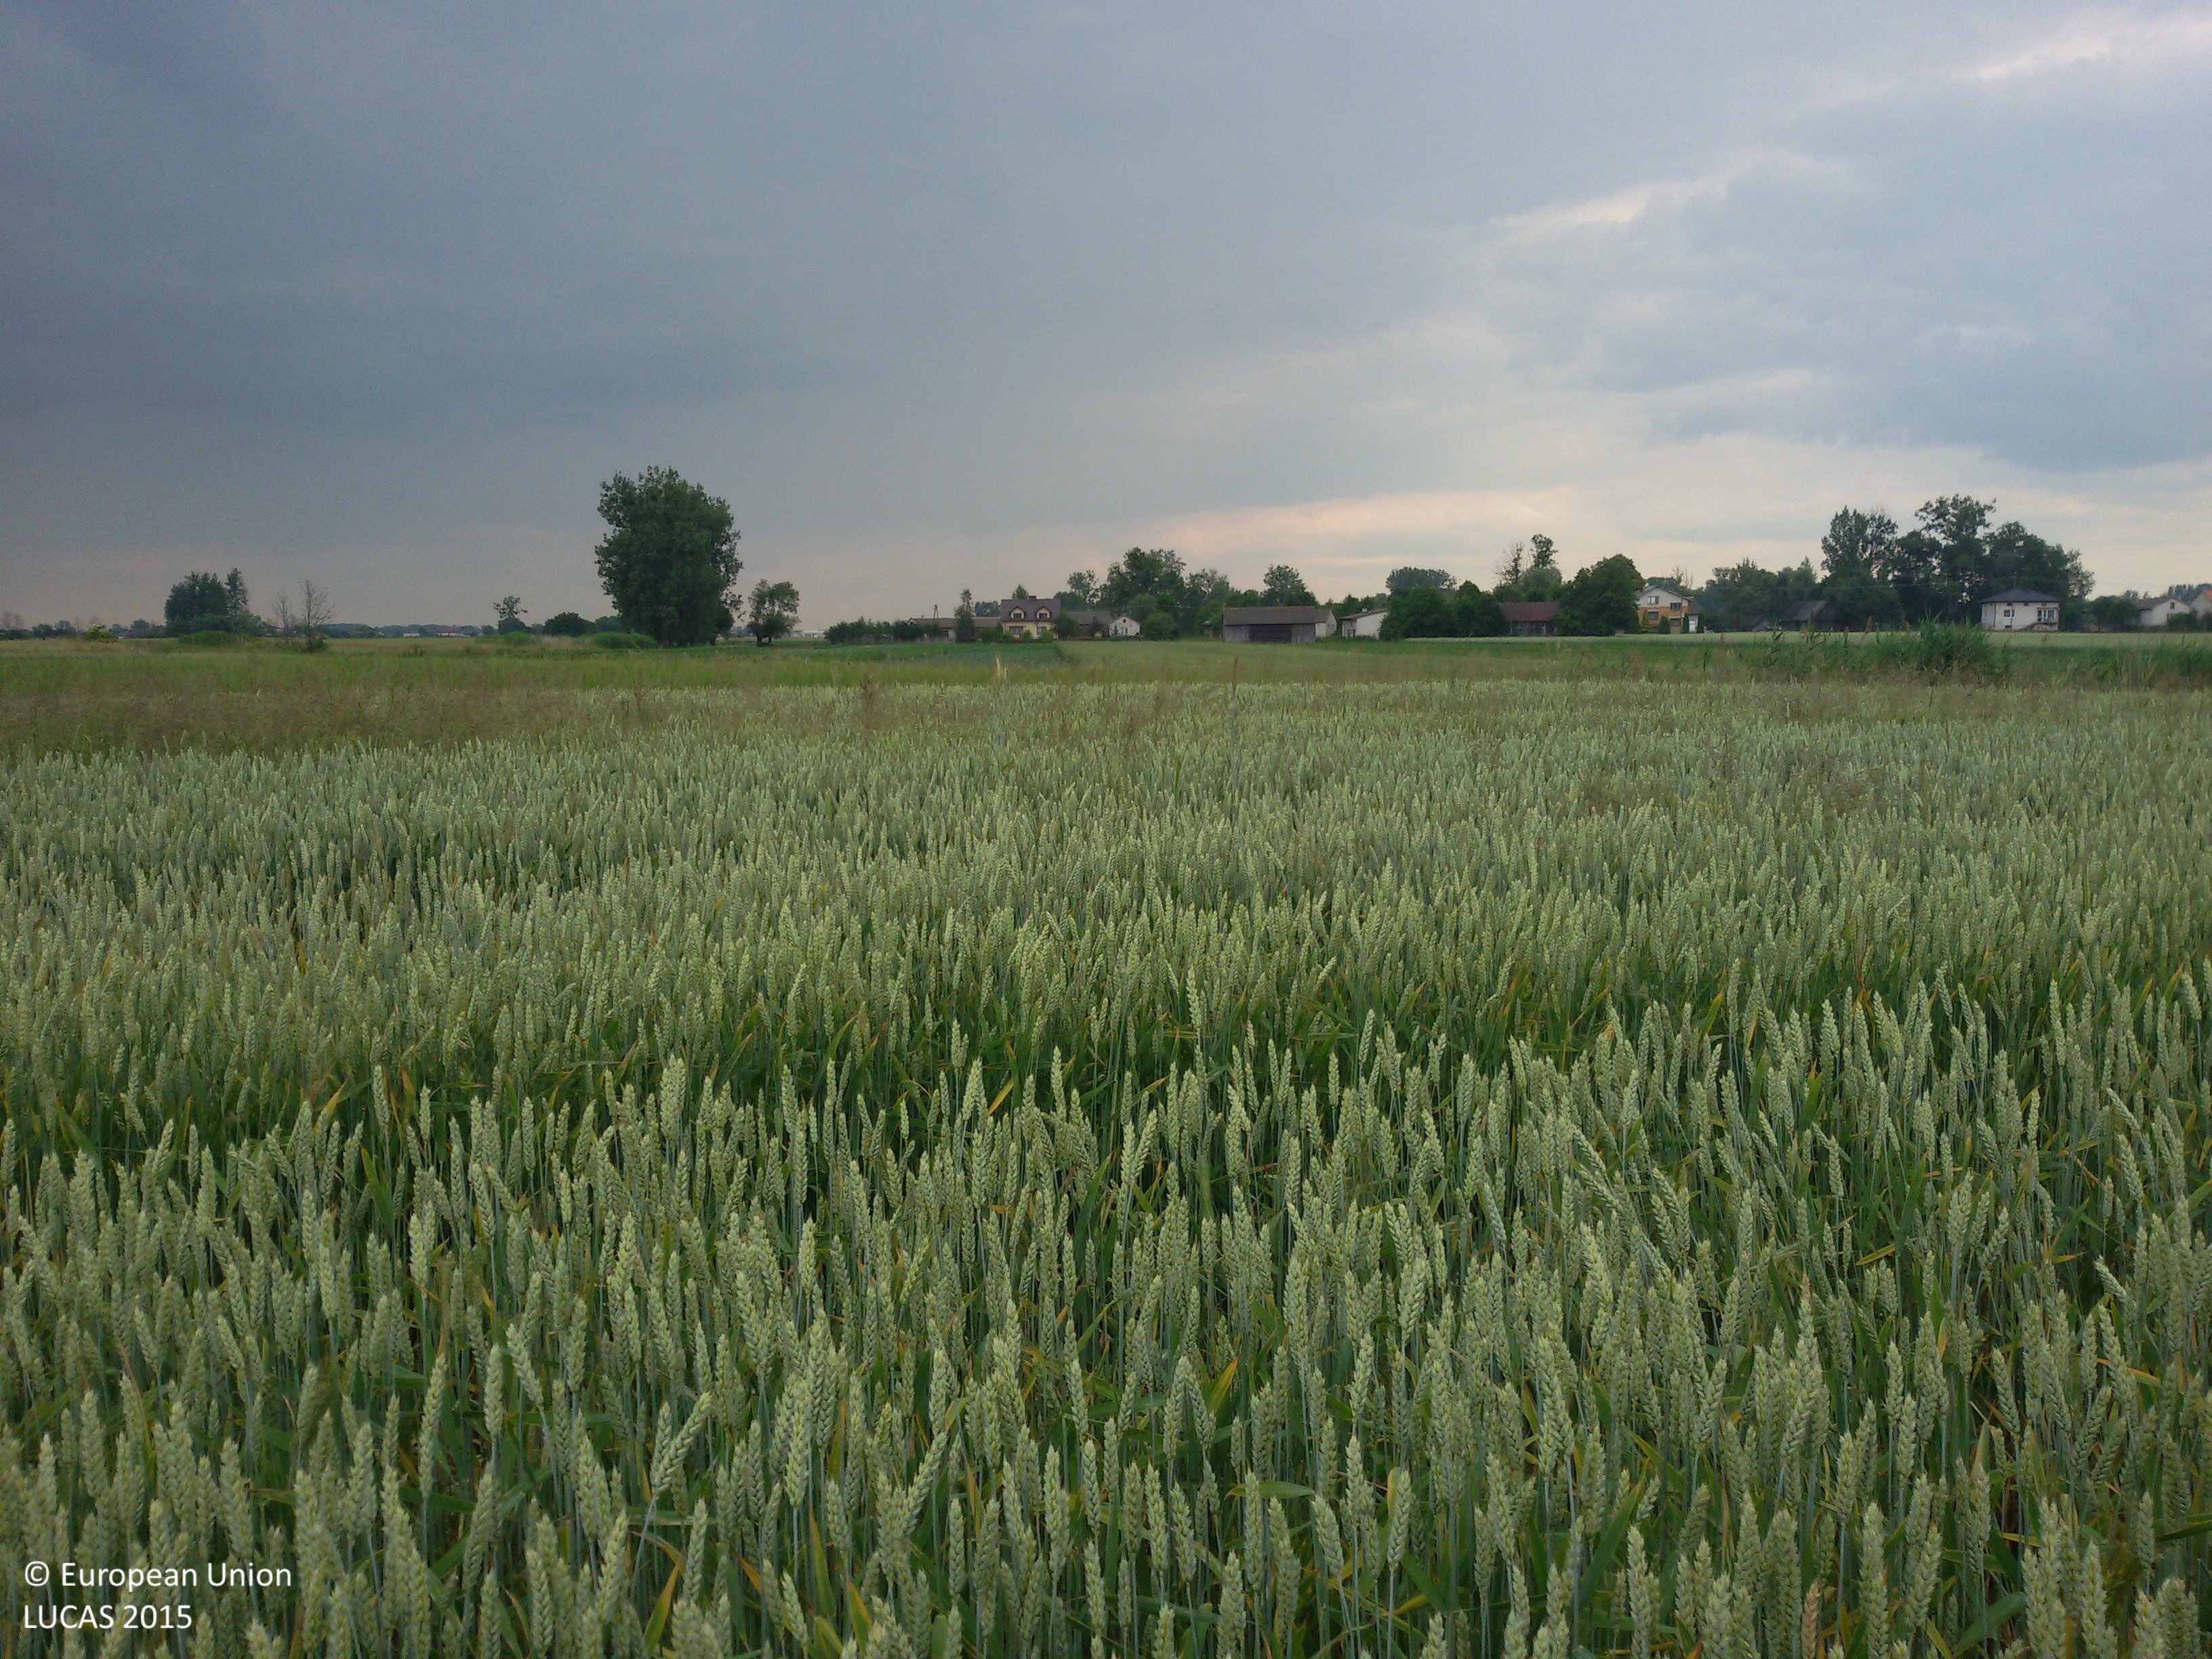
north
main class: Cropland
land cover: Common wheat
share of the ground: > 75 %
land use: Agriculture (excluding fallow land and kitchen gardens)
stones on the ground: < 10 %
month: June
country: PL
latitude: 51.5666
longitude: 21.6377
